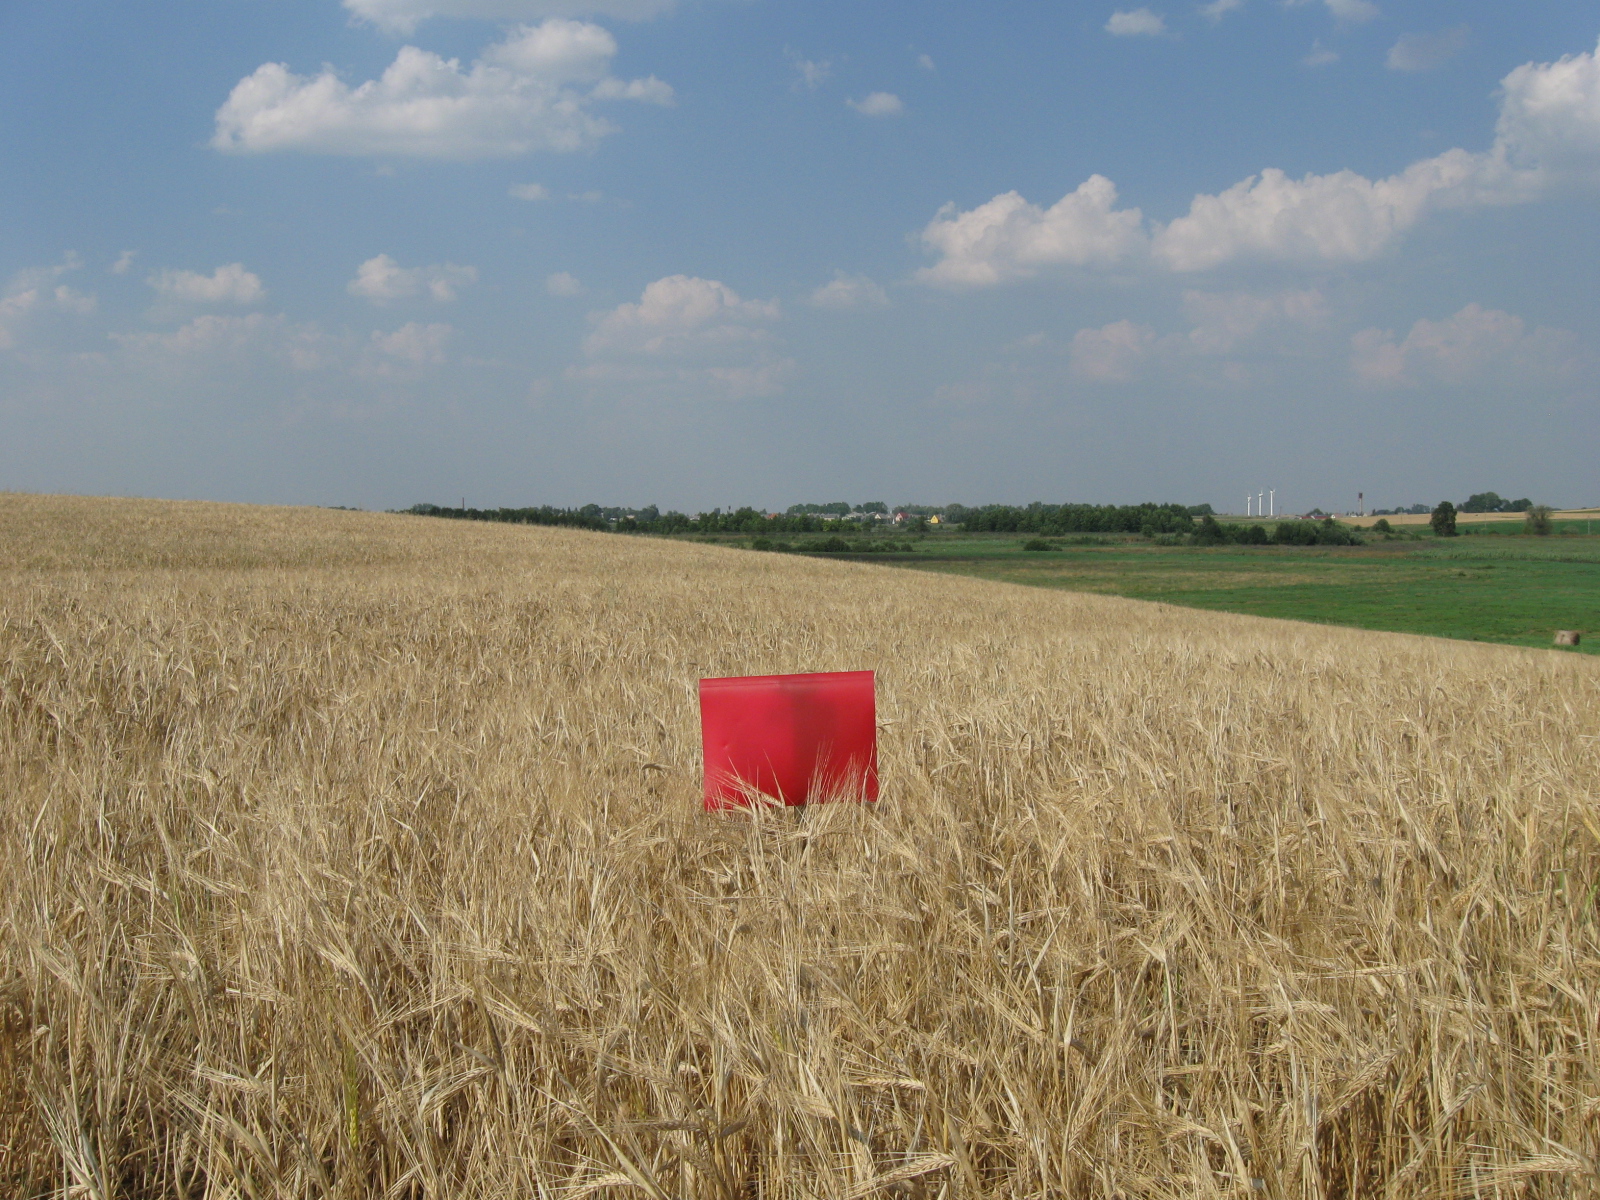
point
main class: Cropland
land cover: Barley
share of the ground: > 75 %
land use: Agriculture (excluding fallow land and kitchen gardens)
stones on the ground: < 10 %
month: August
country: LT
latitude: 54.4198
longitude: 23.2539
